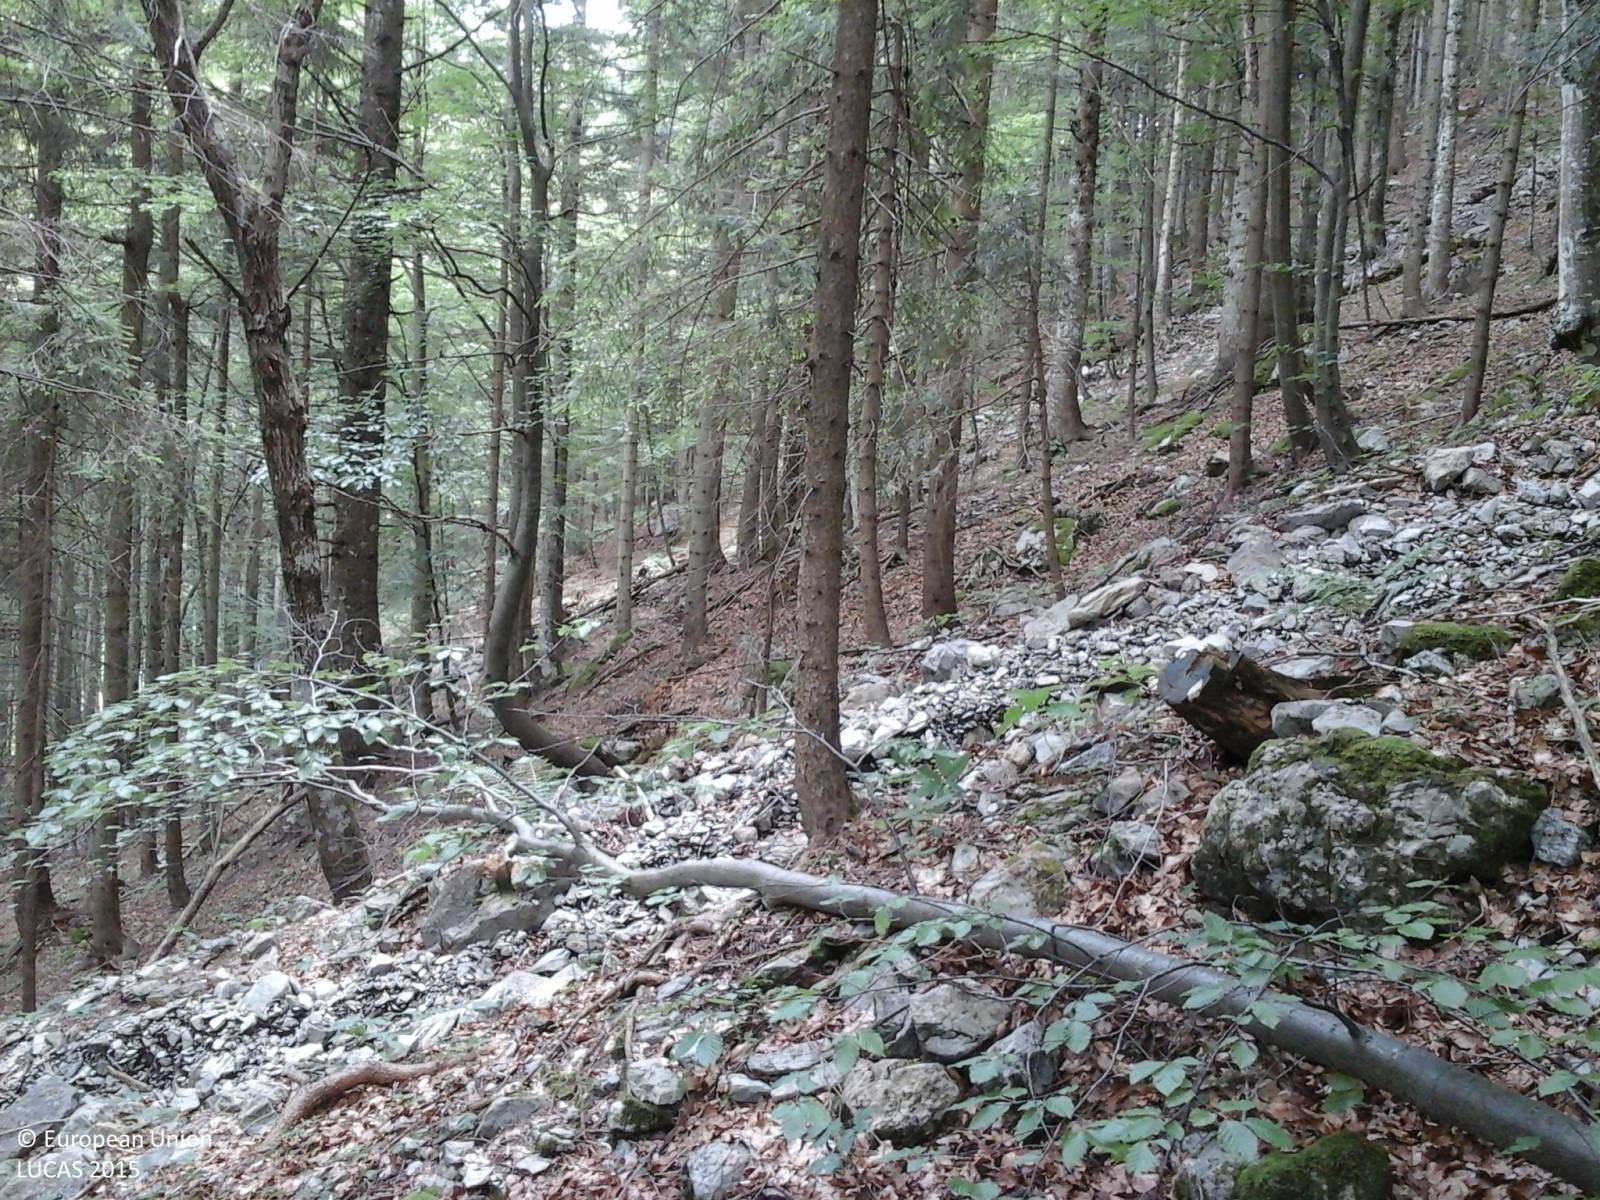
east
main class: Woodland
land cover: Other mixed woodland
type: mountainous beech forest
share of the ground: > 75 %
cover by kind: coniferous forest trees 50 %, broadleaved forest trees 50 %
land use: Forestry
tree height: > 5 m
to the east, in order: Other mixed woodland
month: June
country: IT
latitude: 46.5004
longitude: 13.2416
